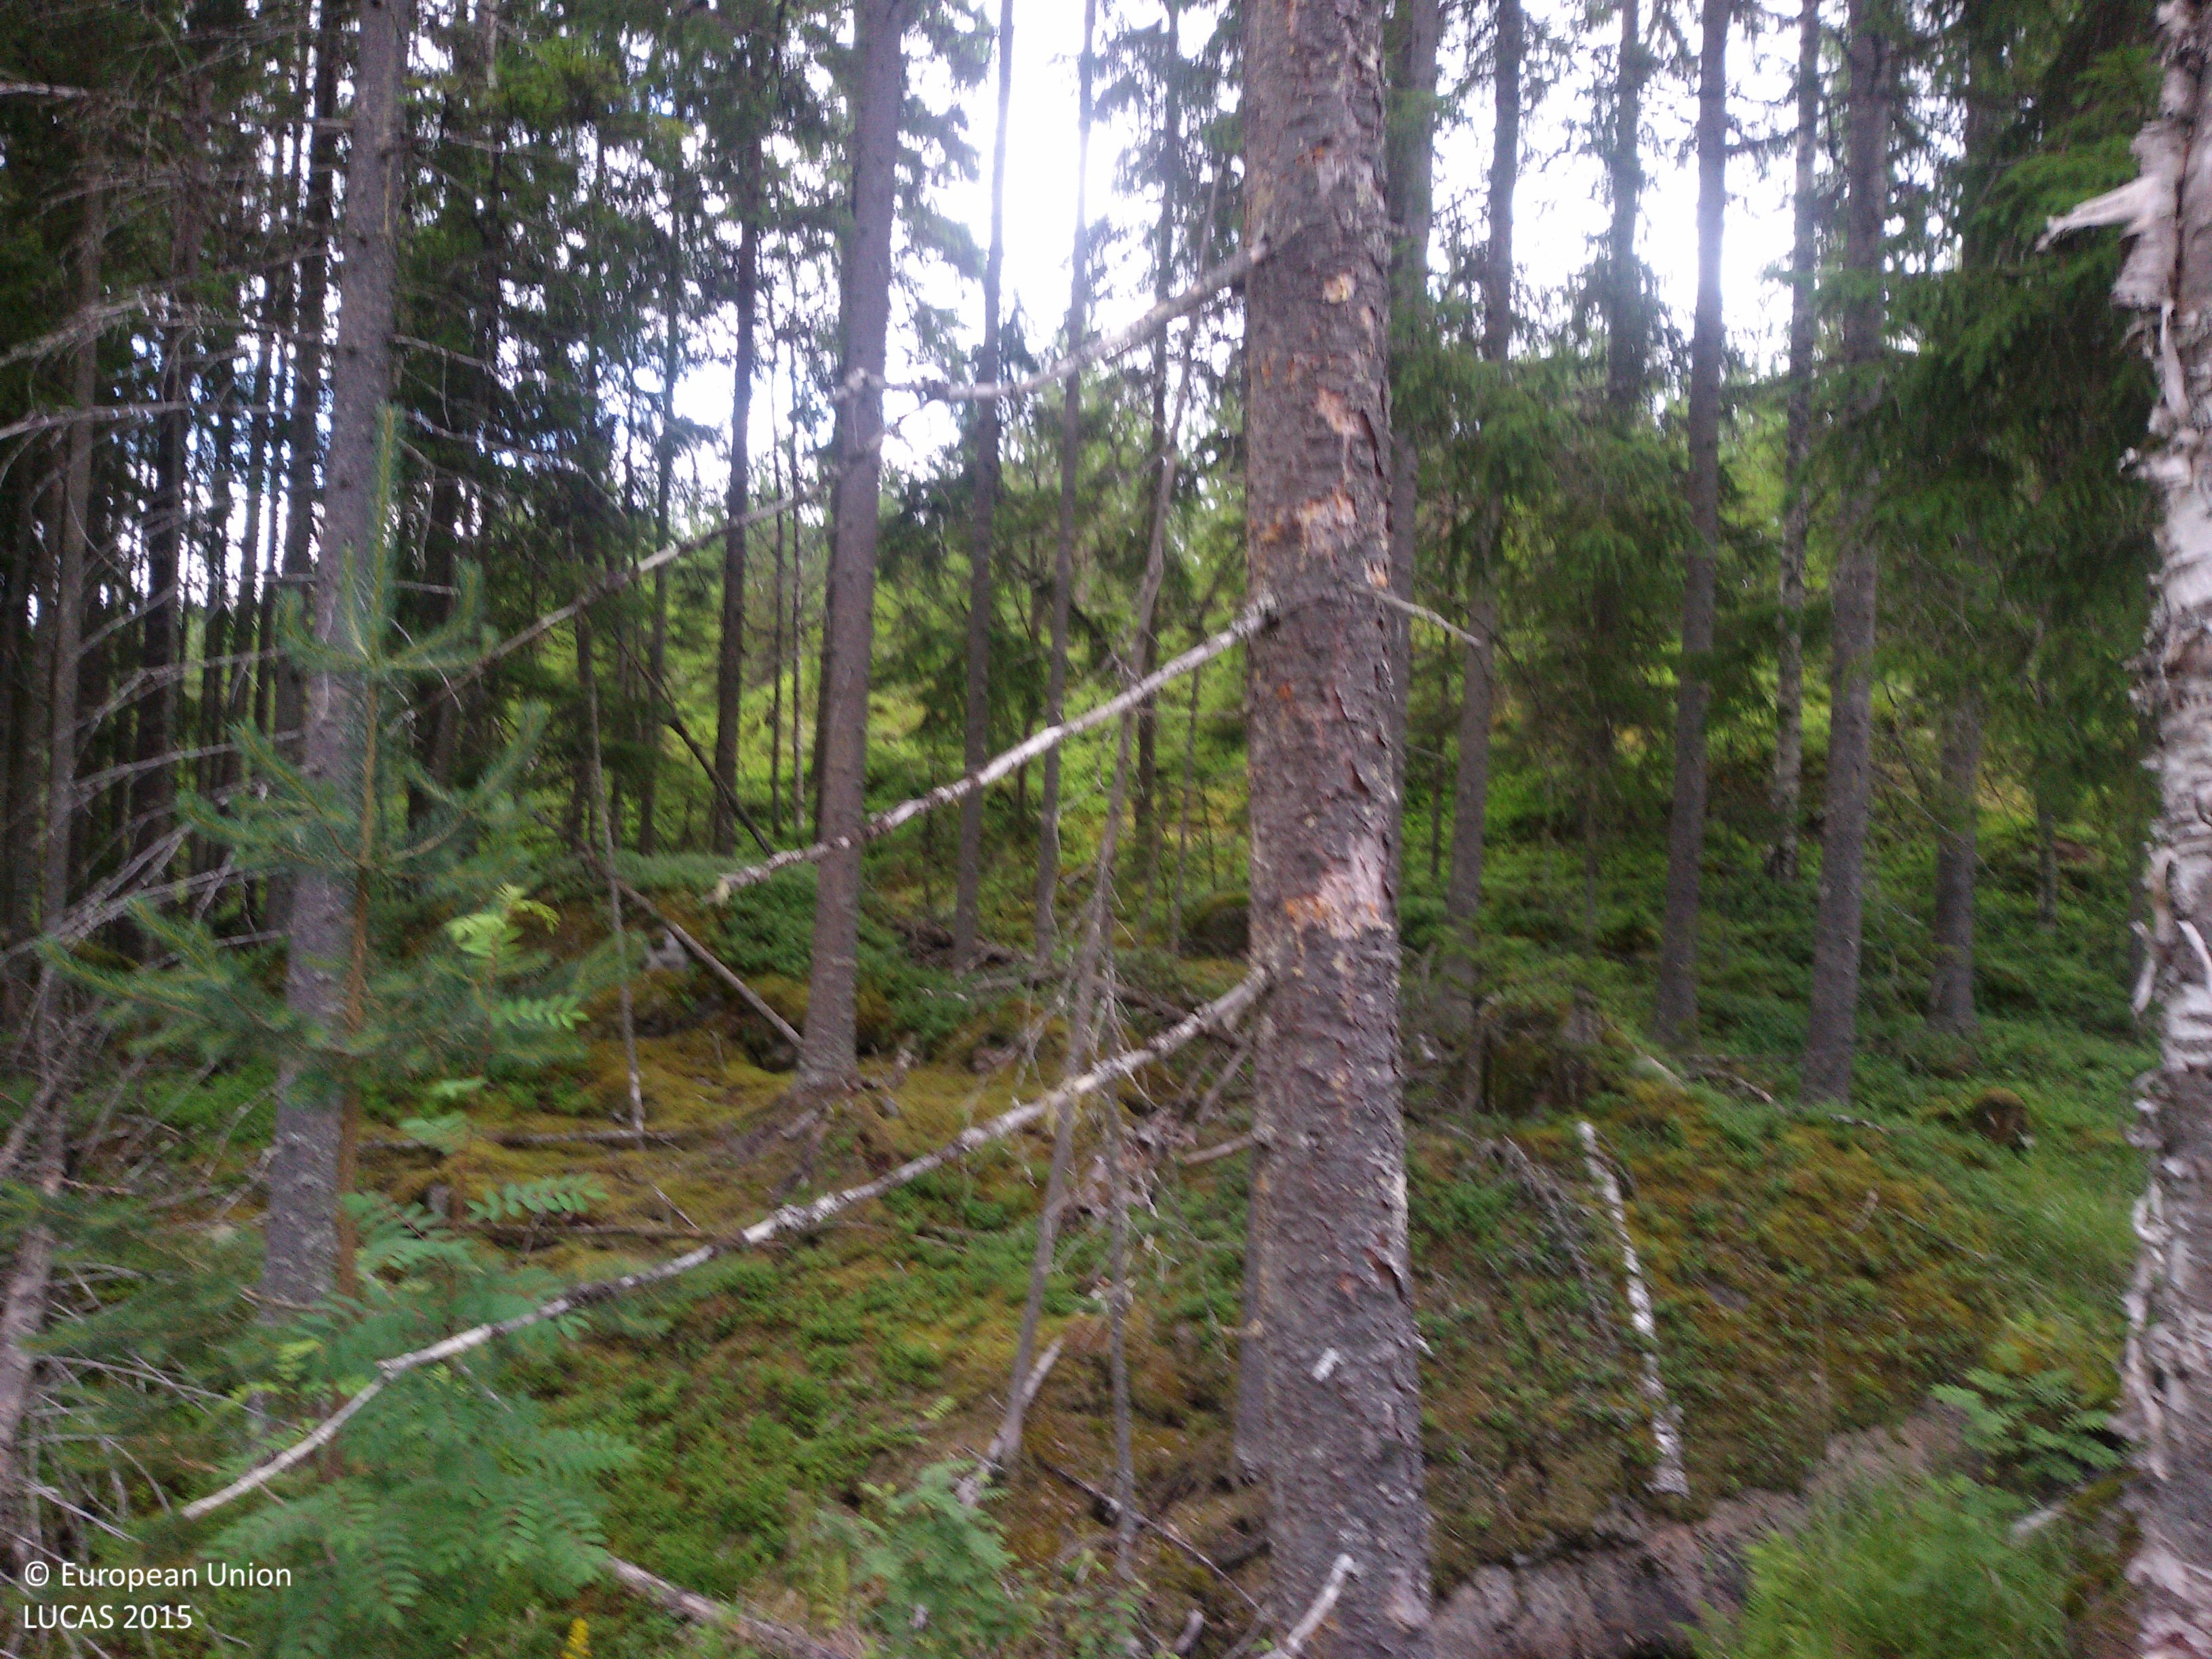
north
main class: Woodland
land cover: Spruce dominated coniferous woodland
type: boreal forest
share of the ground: 50 - 75 %
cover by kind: coniferous forest trees 75 %, shrubs 15 %, herbaceous plants 10 %
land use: Forestry
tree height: > 5 m
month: July
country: SE
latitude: 60.4008
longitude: 14.9431
